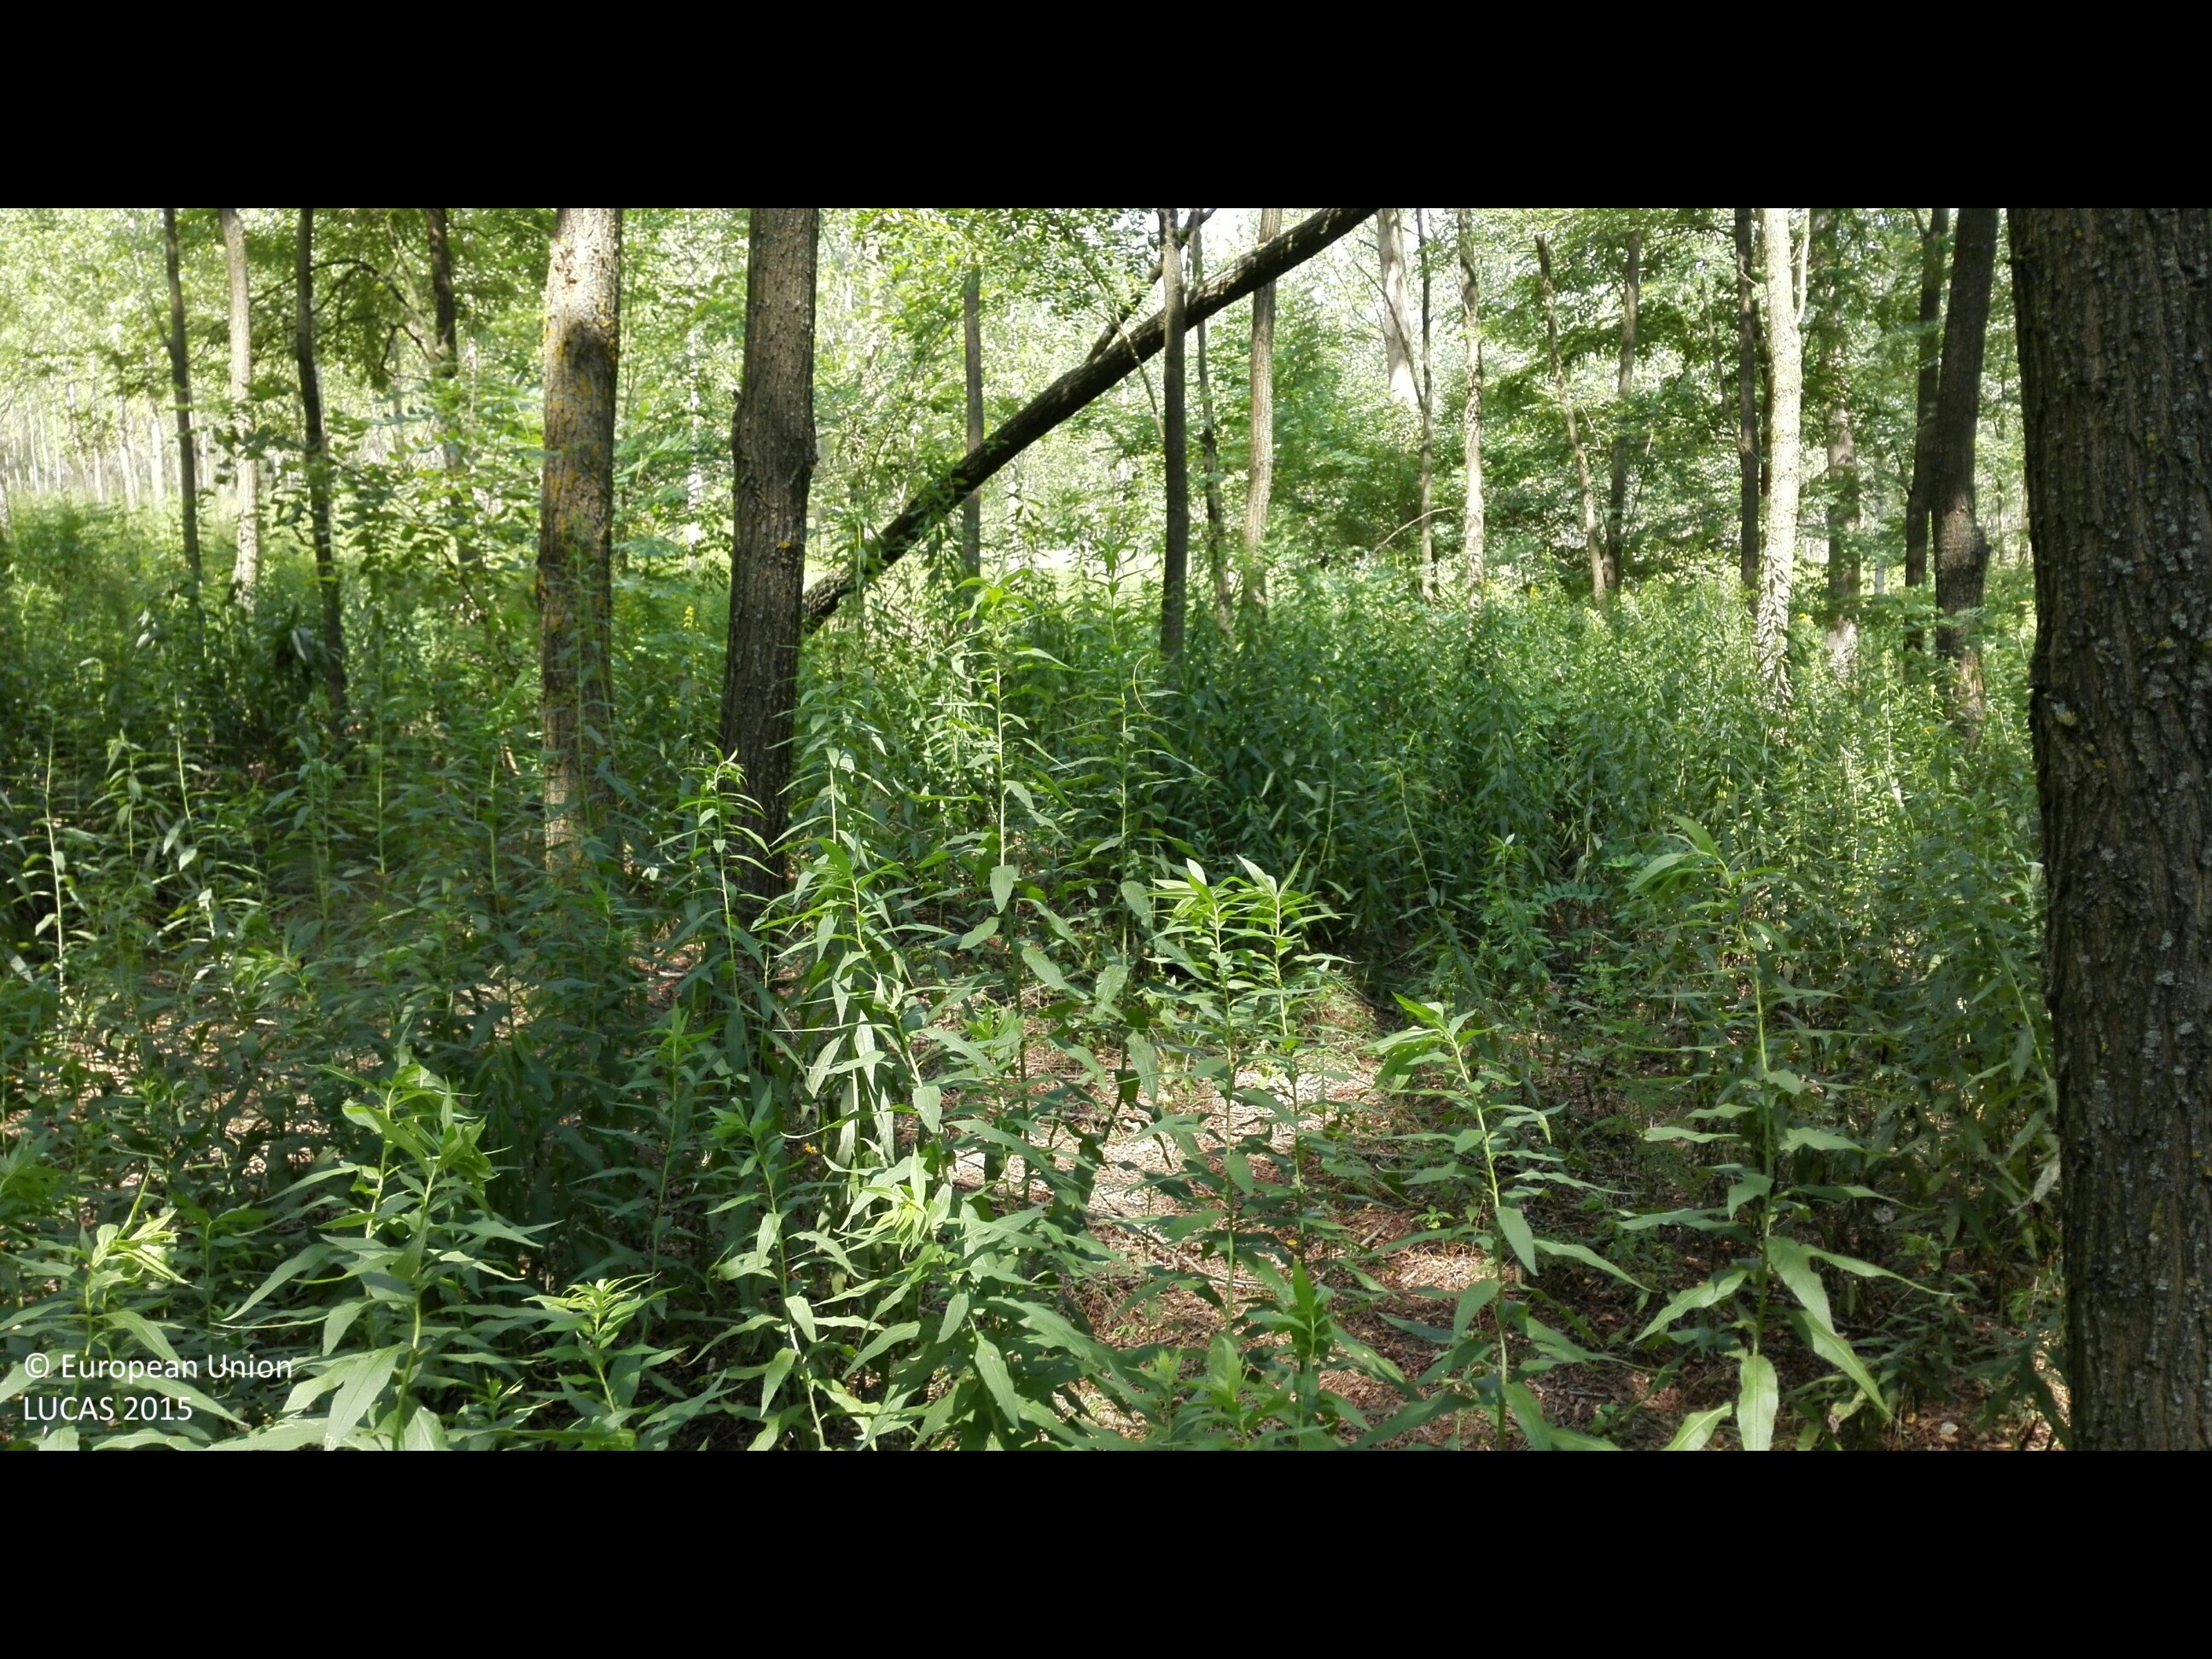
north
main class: Woodland
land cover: Broadleaved woodland
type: exotic forest
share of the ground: > 75 %
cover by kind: broadleaved forest trees 95 %, herbaceous plants 5 %
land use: Forestry
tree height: > 5 m
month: August
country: HU
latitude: 47.6686
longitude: 21.8884
